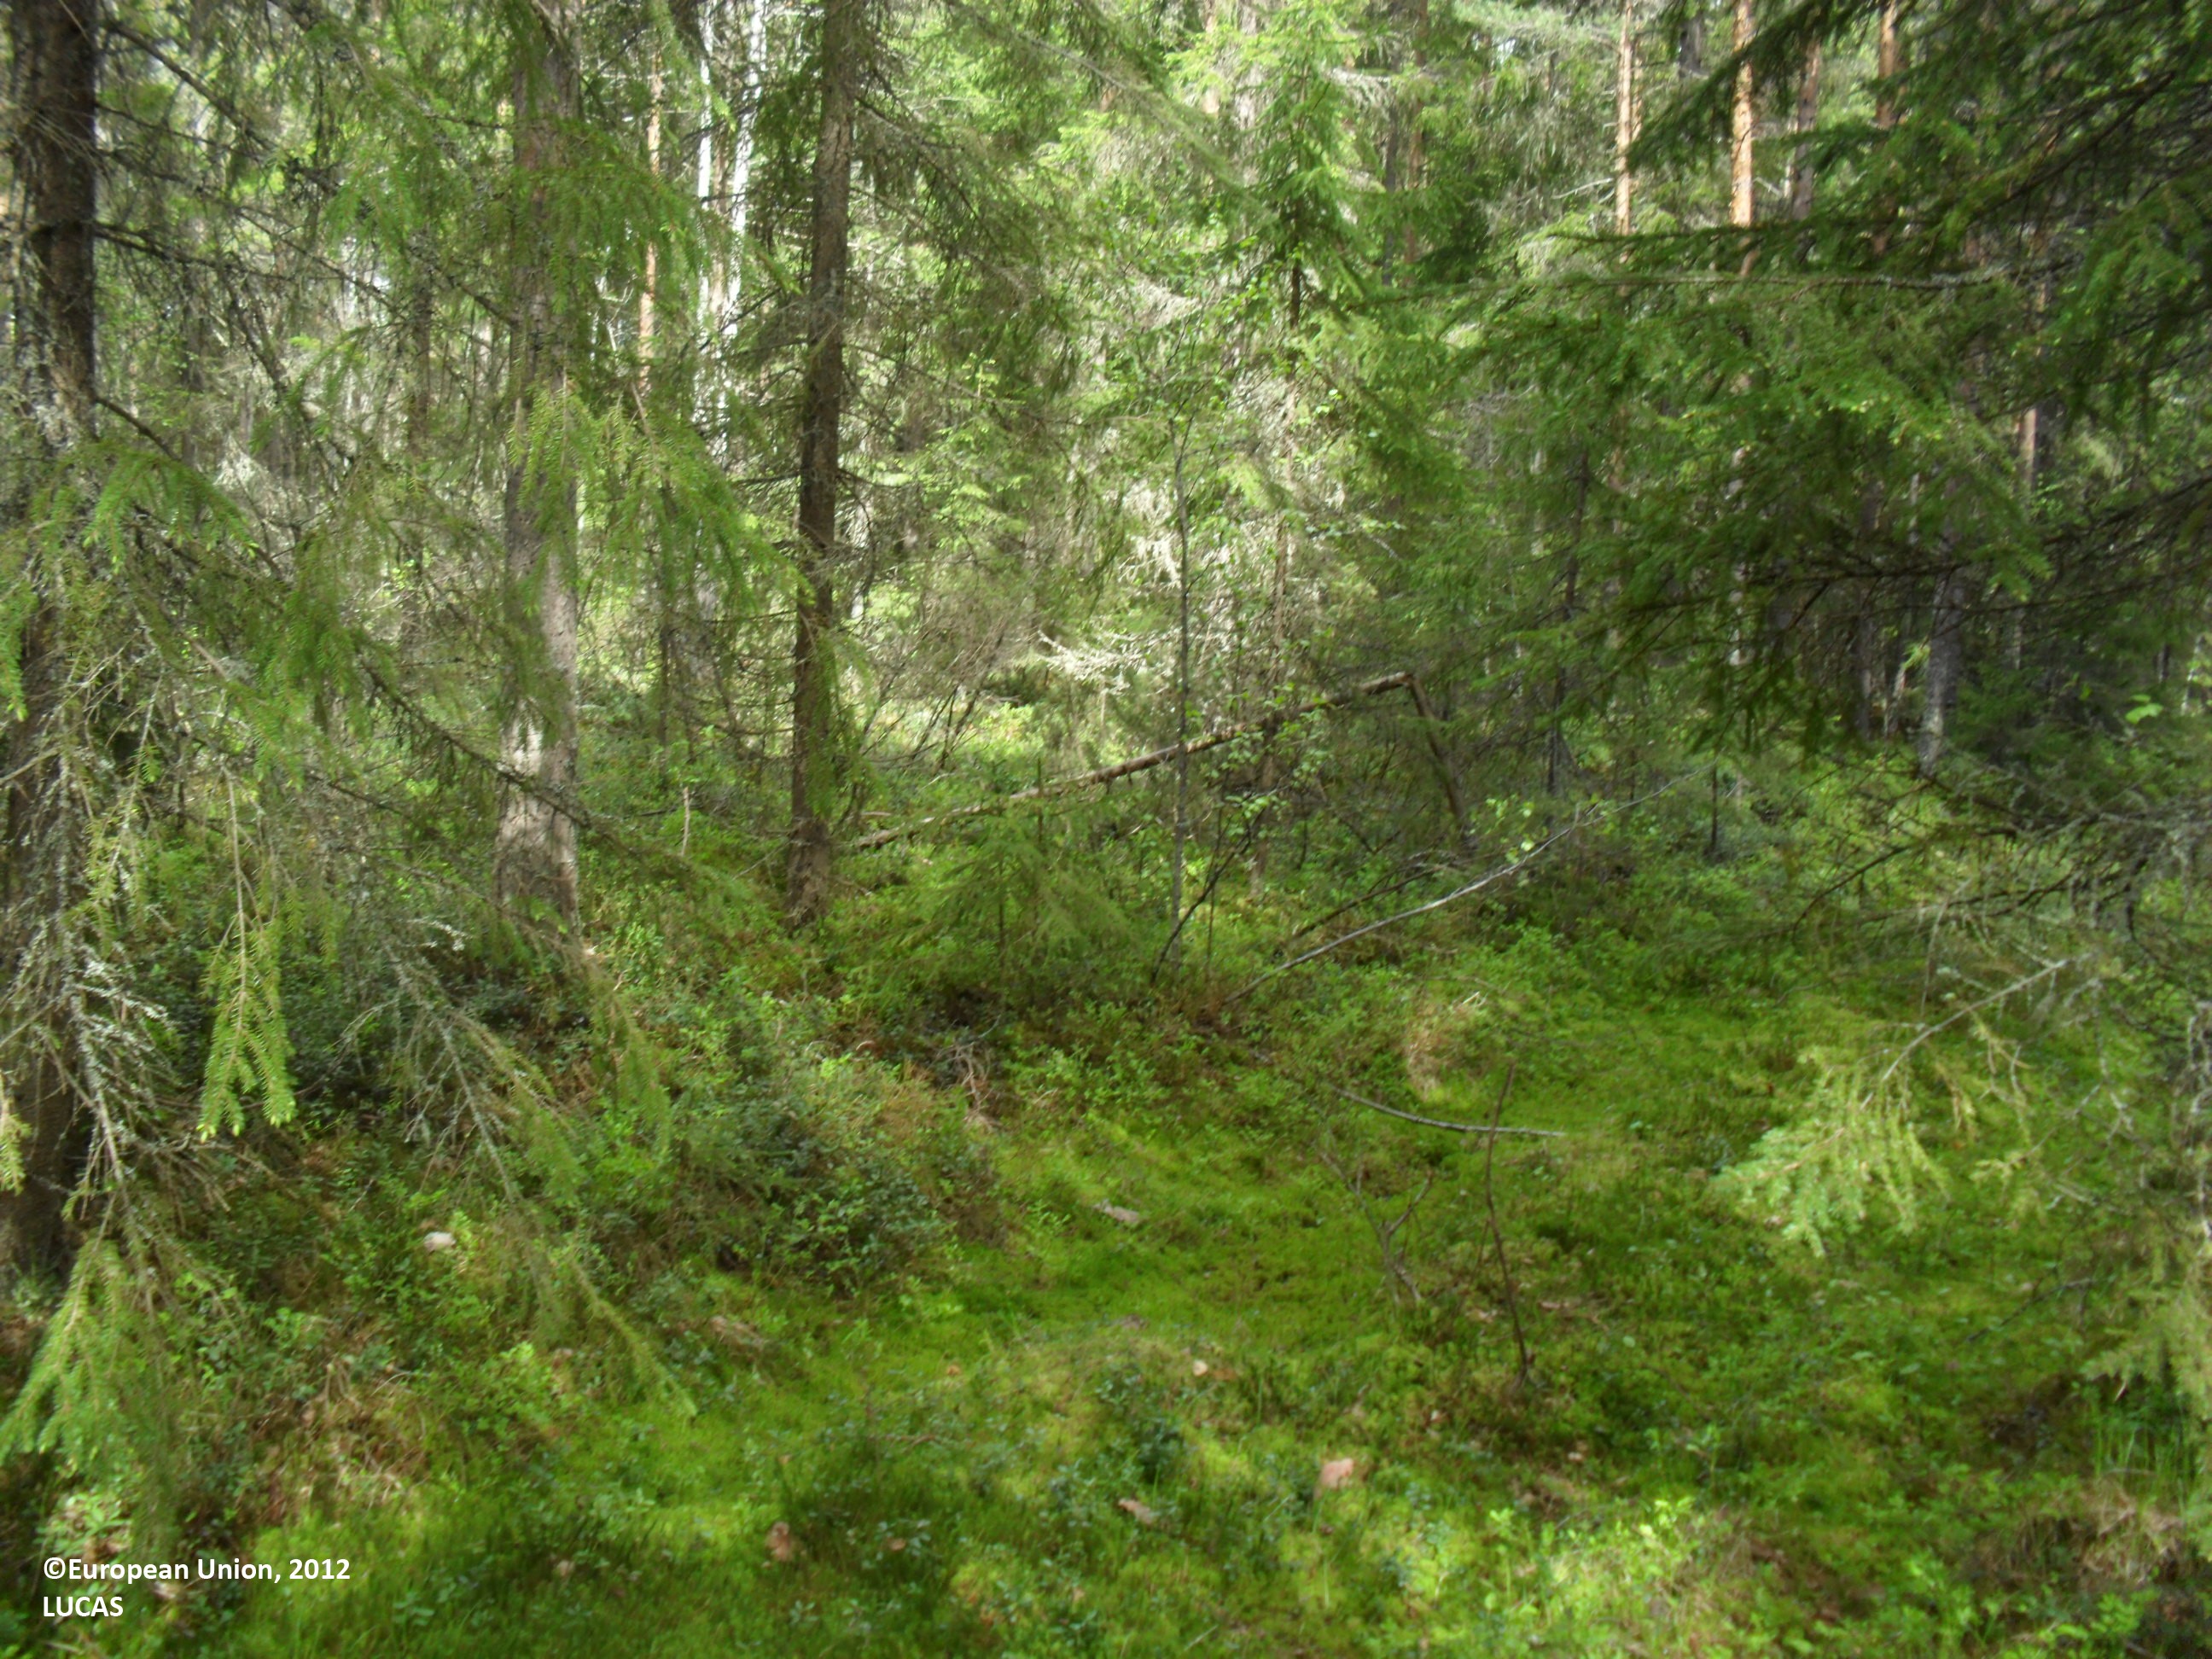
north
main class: Woodland
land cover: Spruce dominated mixed woodland
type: boreal forest
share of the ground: > 75 %
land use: Forestry
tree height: > 5 m
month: June
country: FI
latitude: 62.8742
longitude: 23.3750
